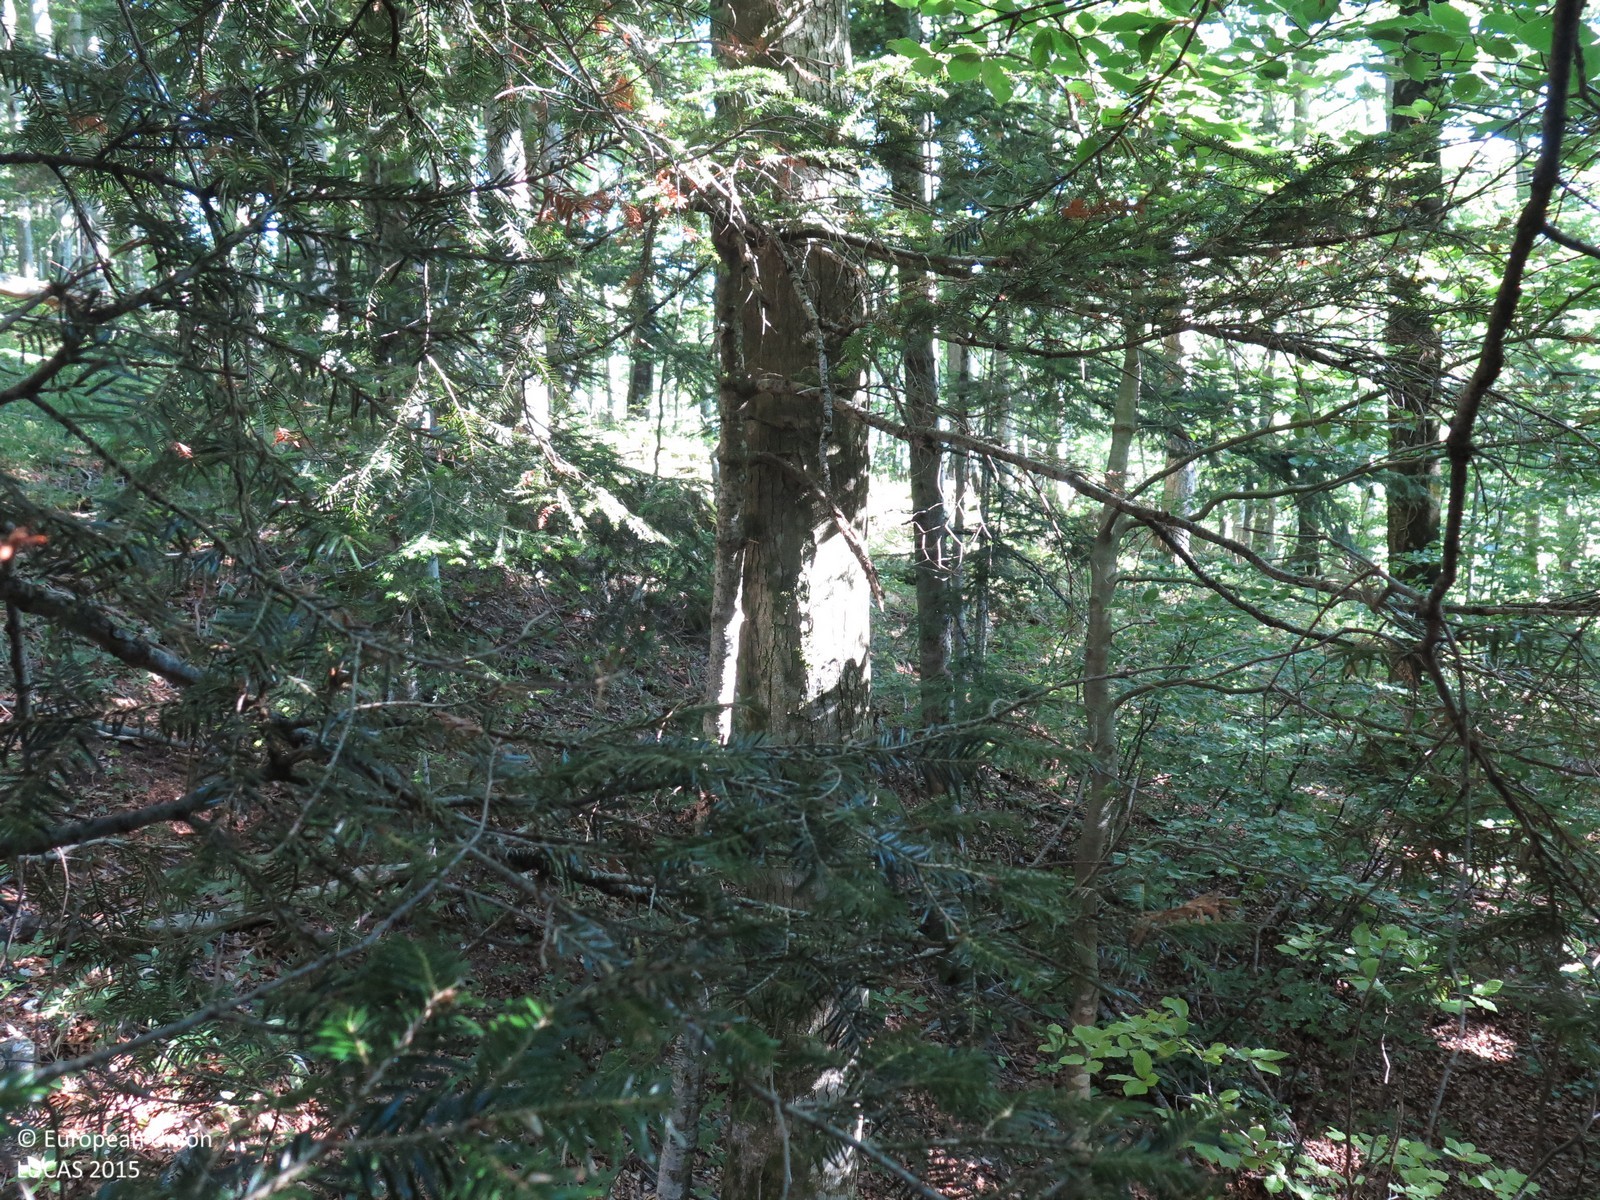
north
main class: Woodland
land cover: Broadleaved woodland
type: beech forest
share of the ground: > 75 %
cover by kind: broadleaved forest trees 95 %, herbaceous plants 5 %
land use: Forestry
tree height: > 5 m
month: August
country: HR
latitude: 45.2329
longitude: 14.7969
